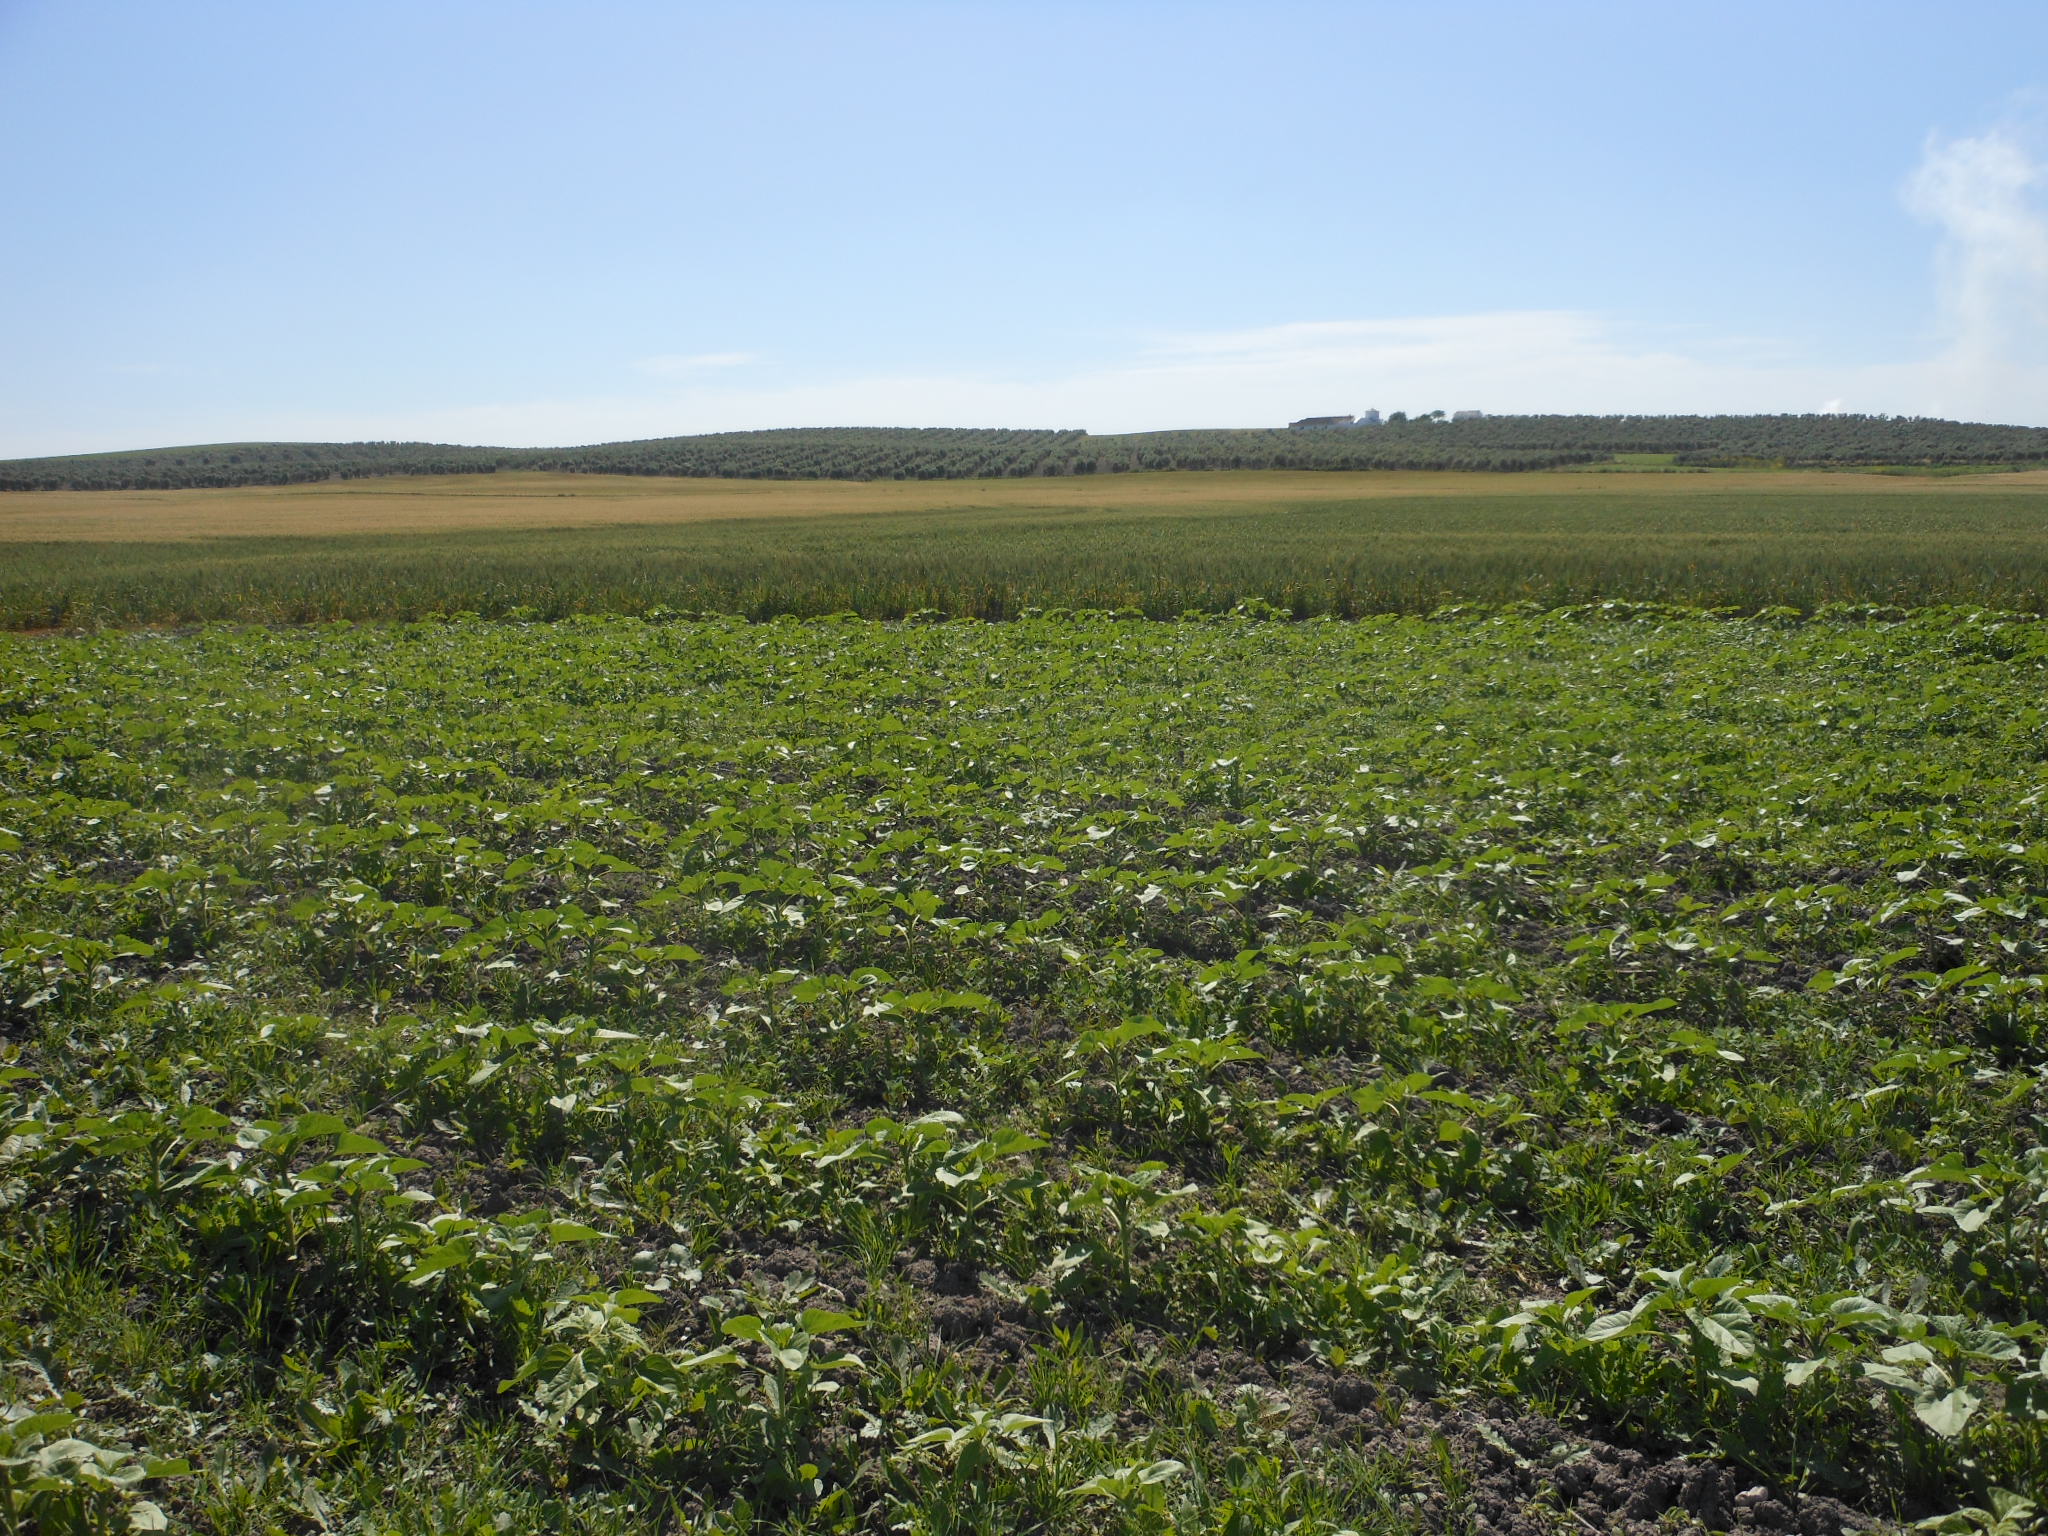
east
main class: Cropland
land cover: Sunflower
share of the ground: 25 - 50 %
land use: Agriculture (excluding fallow land and kitchen gardens)
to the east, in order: Sunflower; Grass margins; Durum wheat
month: April
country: ES
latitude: 37.3751
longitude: -5.4751
